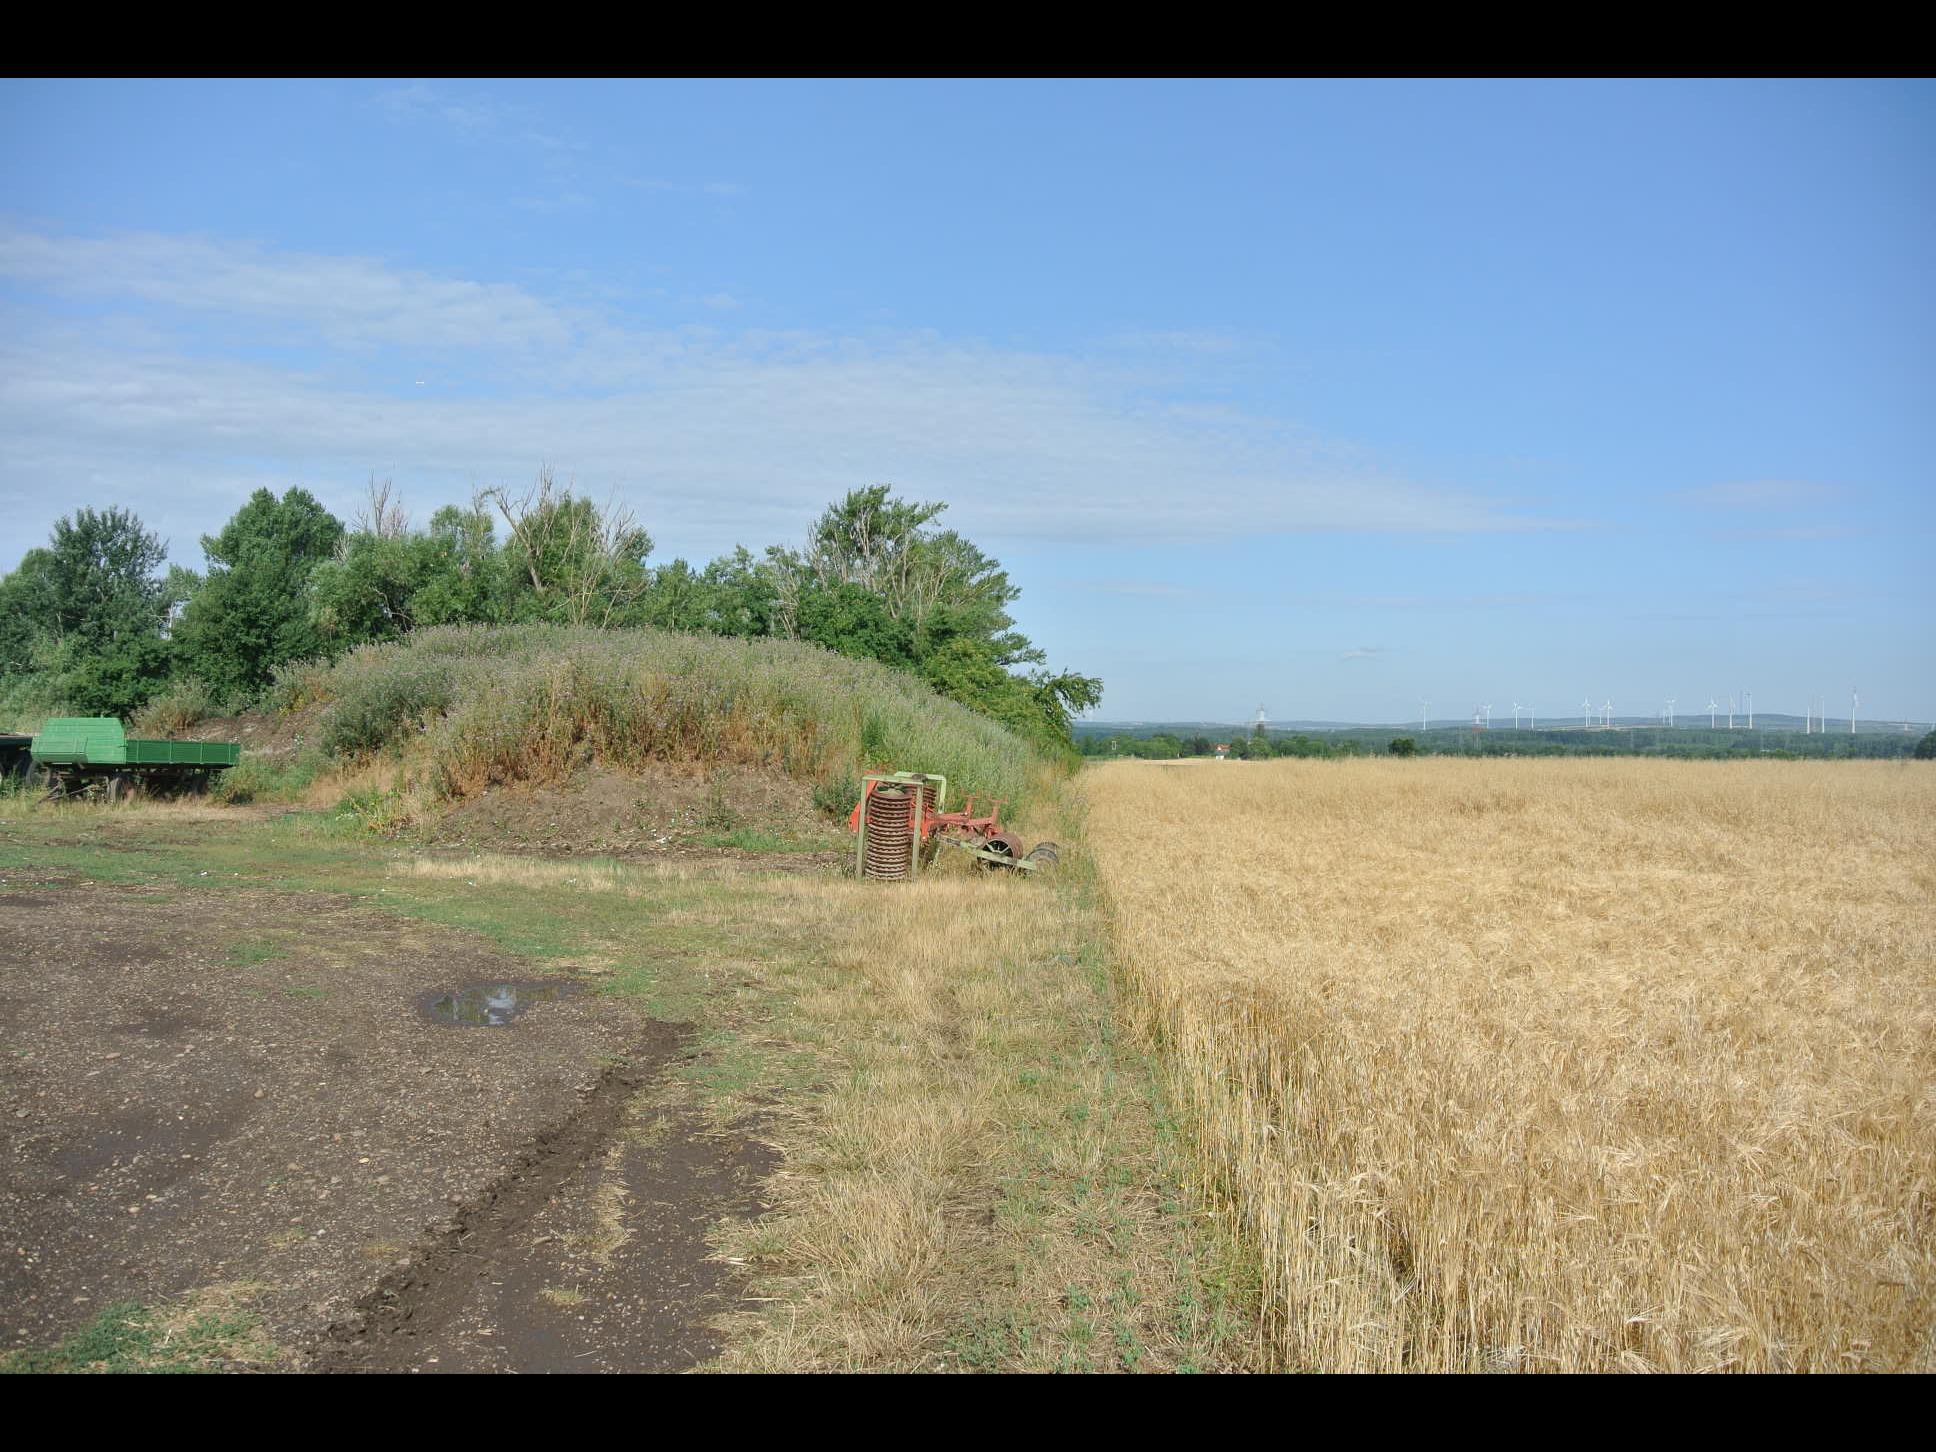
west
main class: Cropland
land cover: Mixed cereals for fodder
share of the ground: > 75 %
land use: Agriculture (excluding fallow land and kitchen gardens)
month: July
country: AT
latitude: 48.0100
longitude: 16.8565
